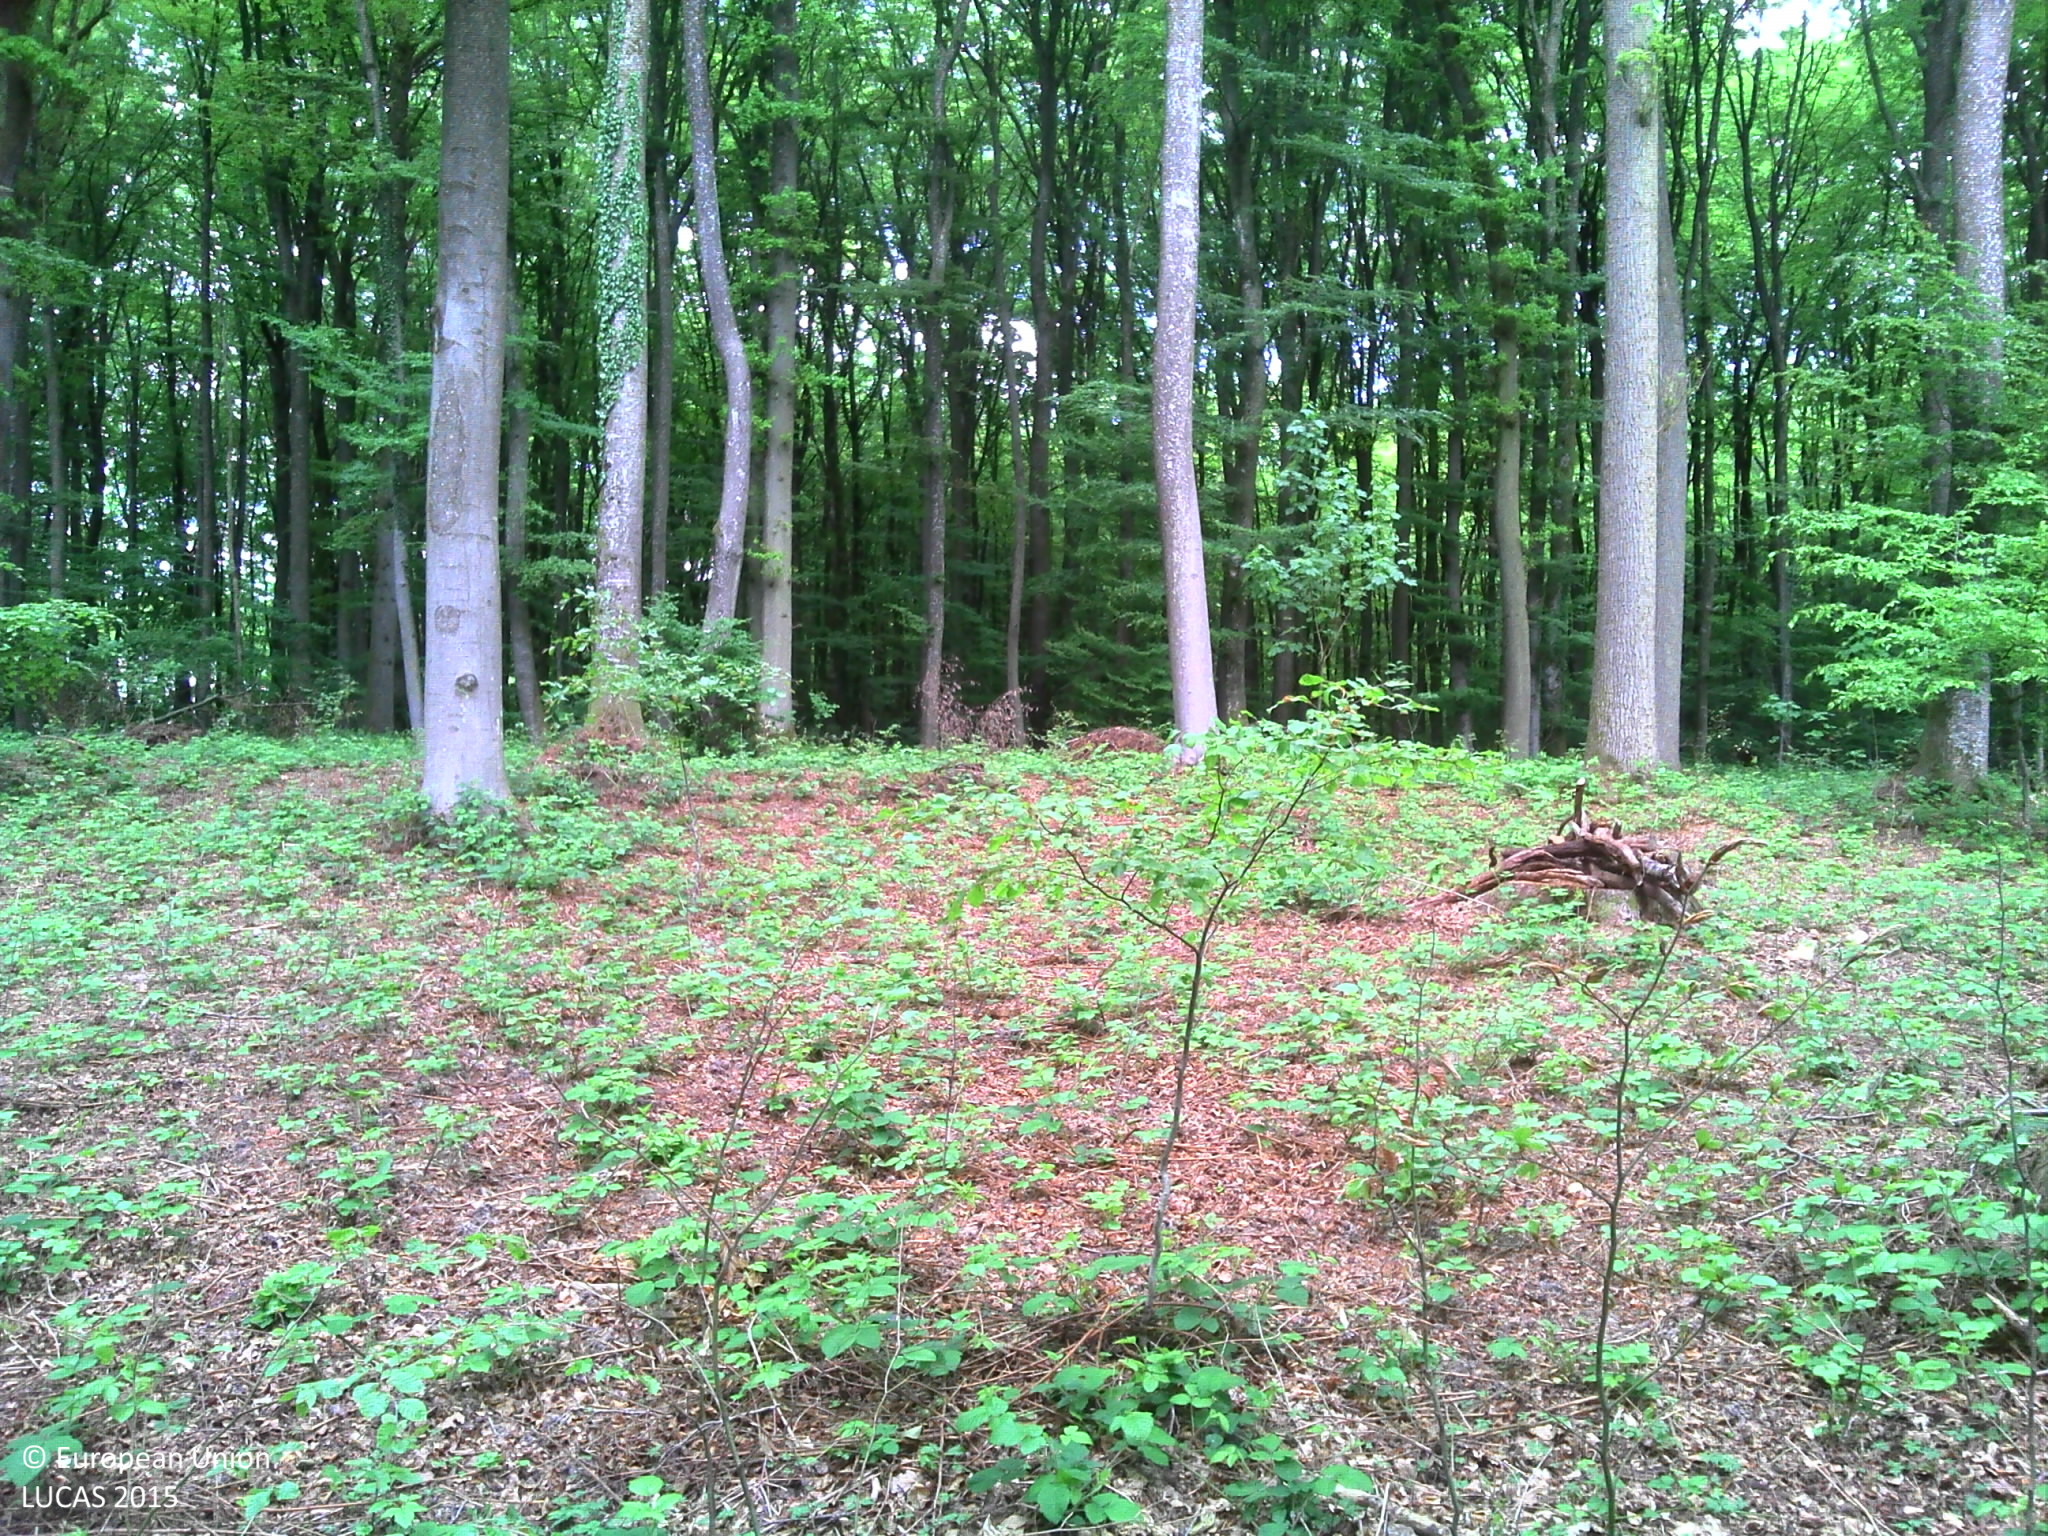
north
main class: Woodland
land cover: Broadleaved woodland
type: beech forest
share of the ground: > 75 %
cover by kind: broadleaved forest trees 85 %, herbaceous plants 10 %, lichens and mosses 5 %
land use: Forestry
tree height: > 5 m
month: May
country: LU
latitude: 49.7685
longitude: 5.9032
